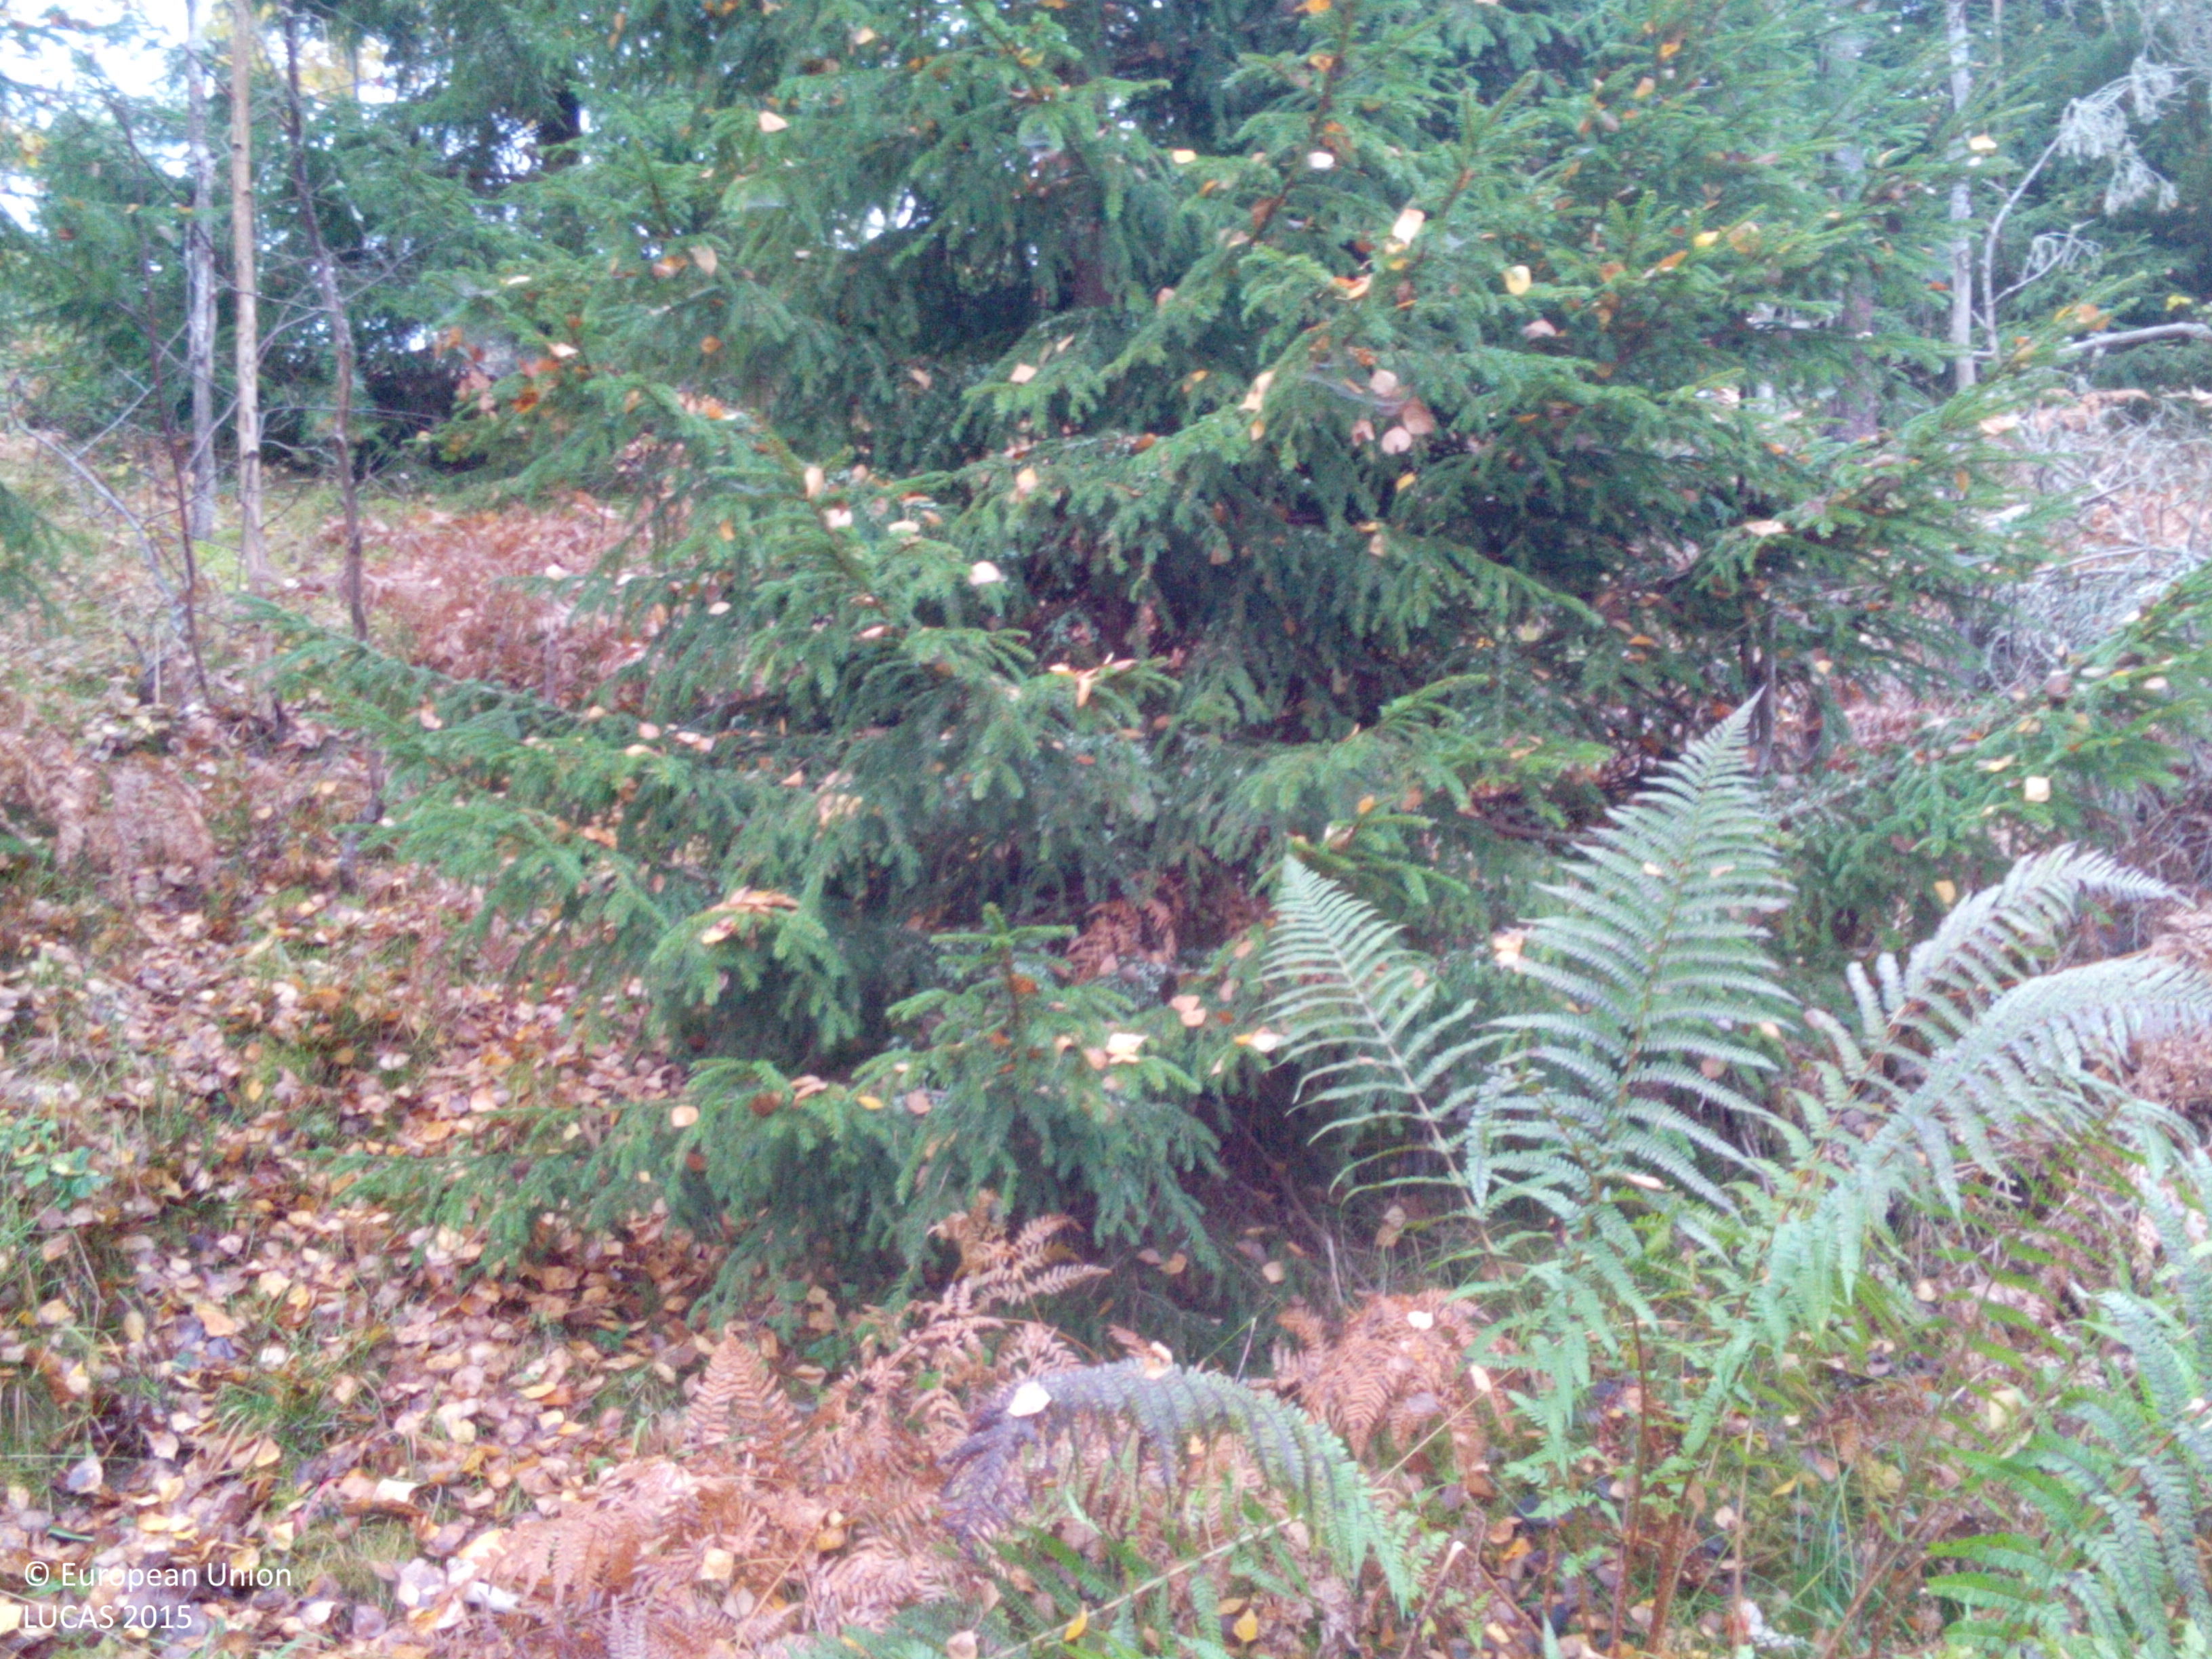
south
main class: Woodland
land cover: Spruce dominated mixed woodland
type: boreal forest
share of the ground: > 75 %
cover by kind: coniferous forest trees 60 %, broadleaved forest trees 25 %, herbaceous plants 15 %
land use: Forestry
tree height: > 5 m
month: October
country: SE
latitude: 58.9692
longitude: 16.4119
